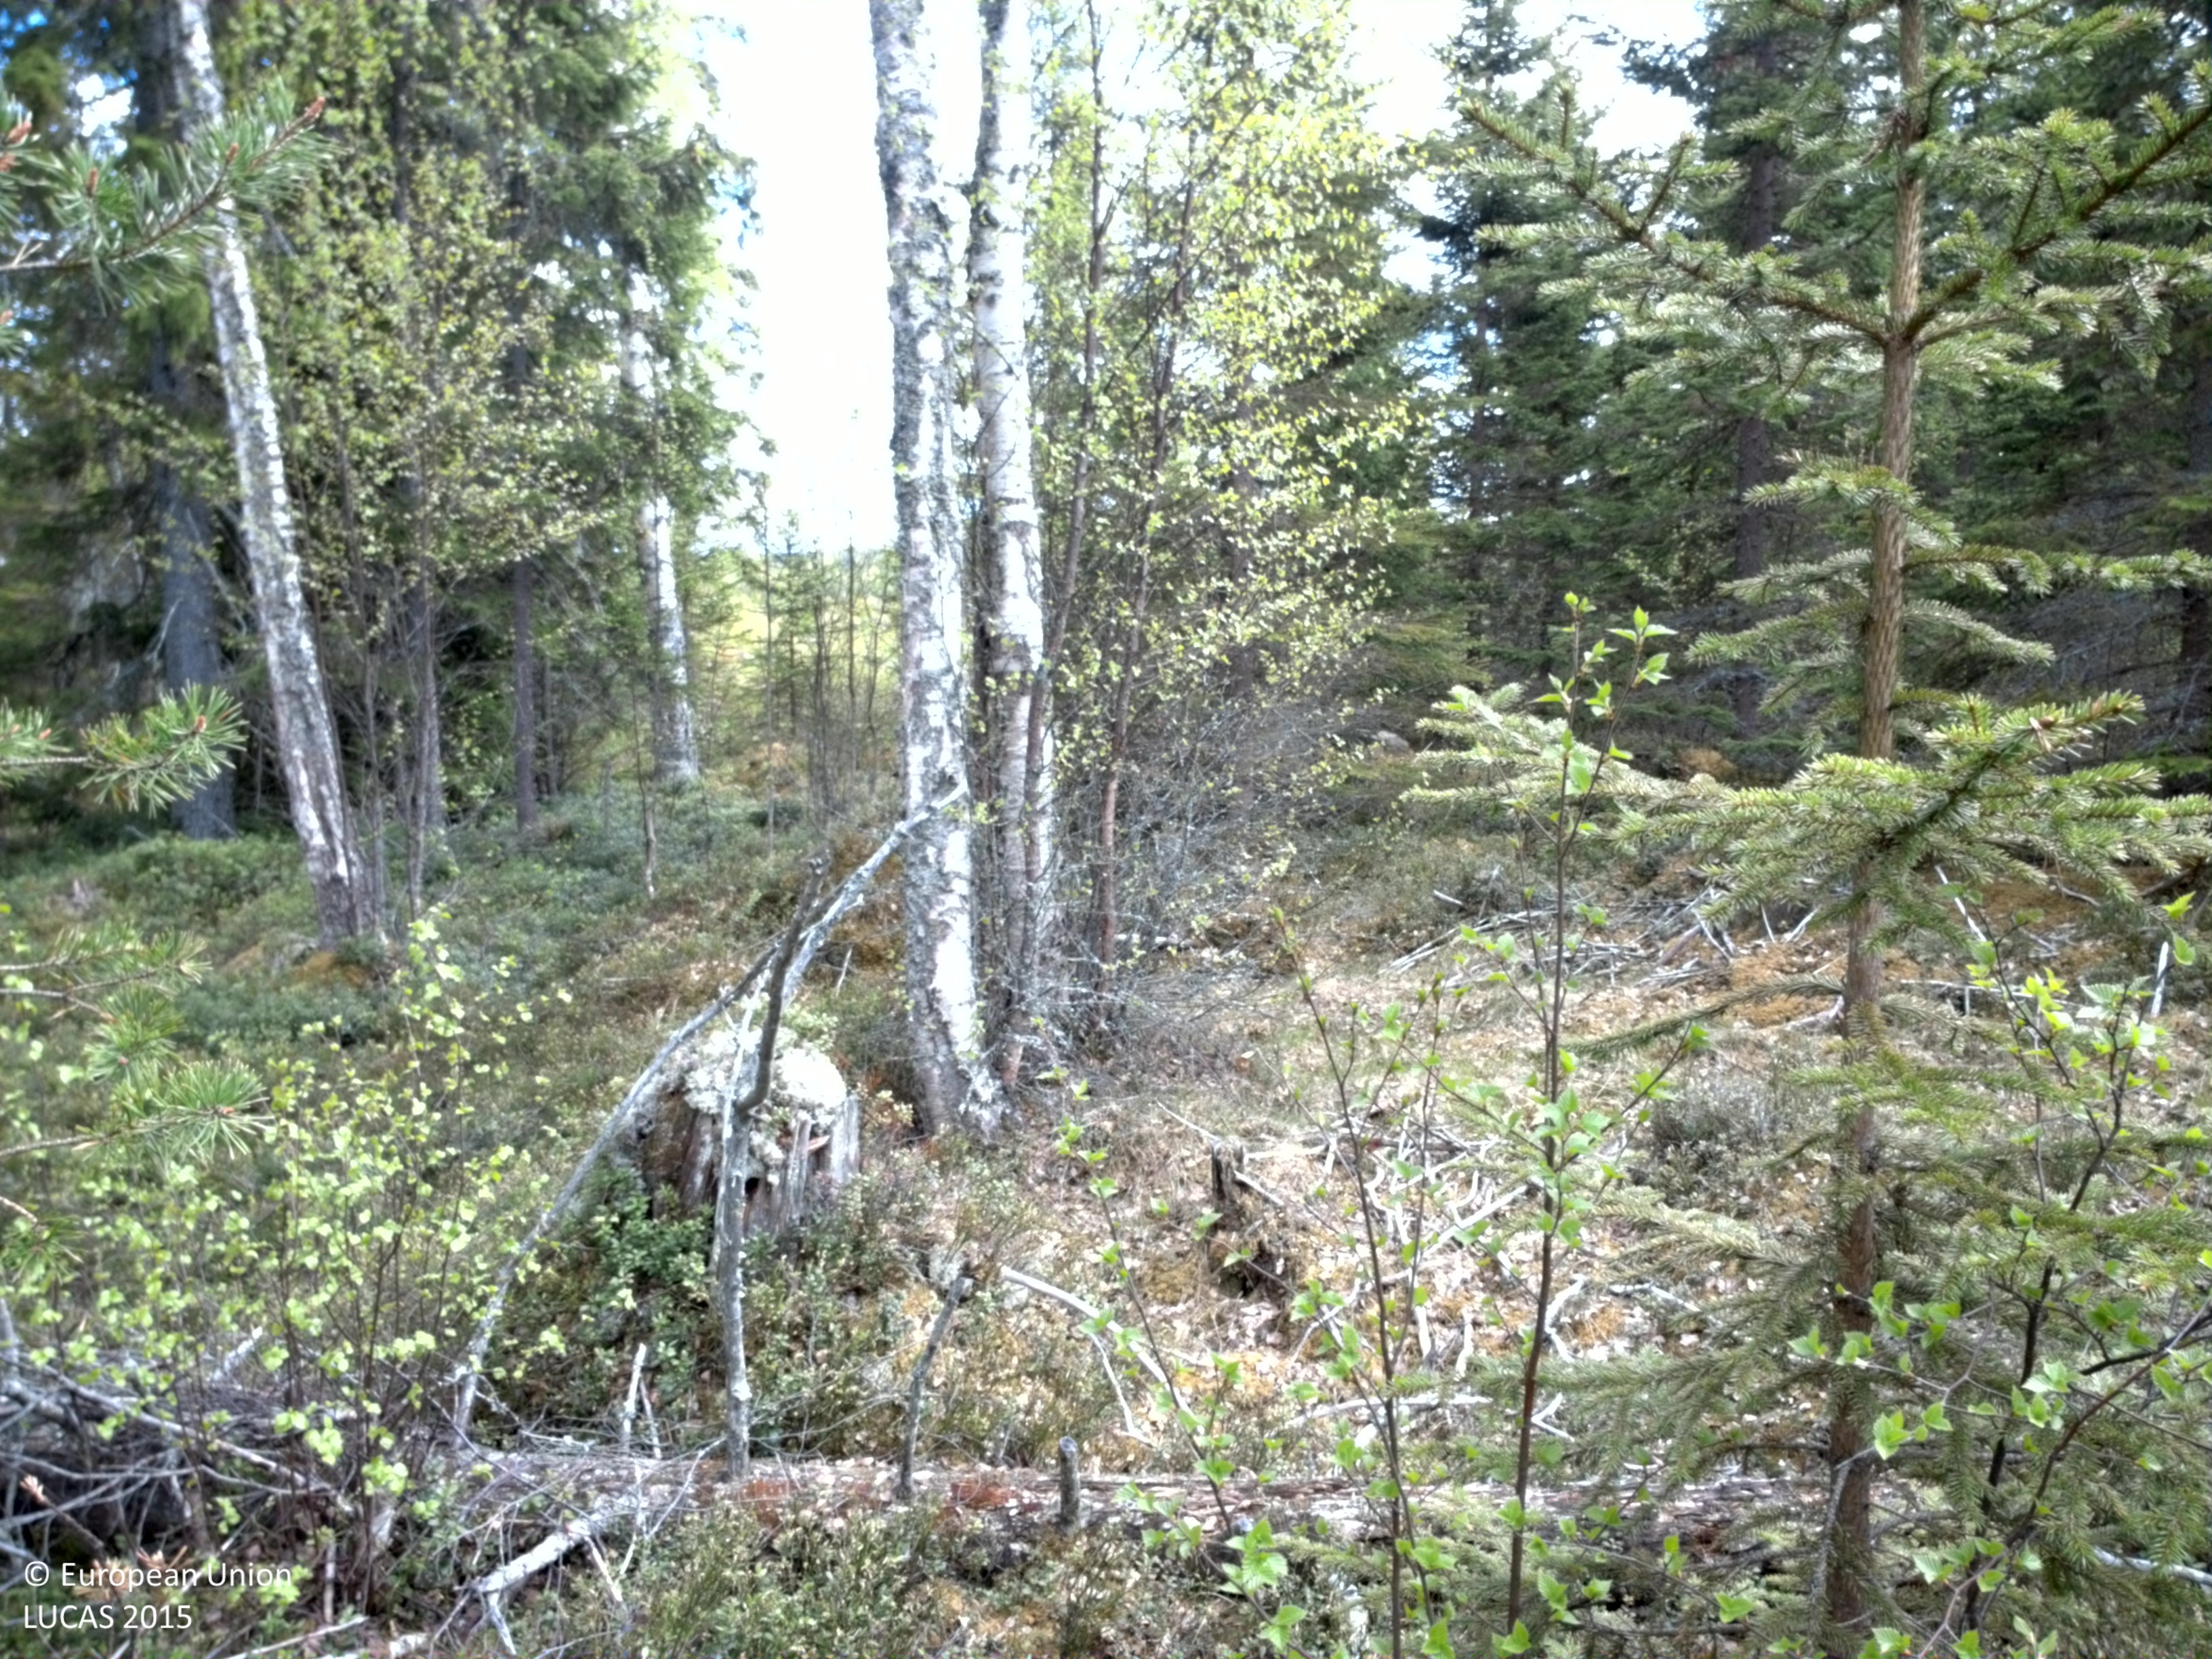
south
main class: Woodland
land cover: Spruce dominated mixed woodland
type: boreal forest
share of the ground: 50 - 75 %
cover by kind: shrubs 35 %, coniferous forest trees 30 %, broadleaved forest trees 25 %, lichens and mosses 10 %
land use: Forestry
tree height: > 5 m
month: May
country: SE
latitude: 61.1207
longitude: 15.4981
